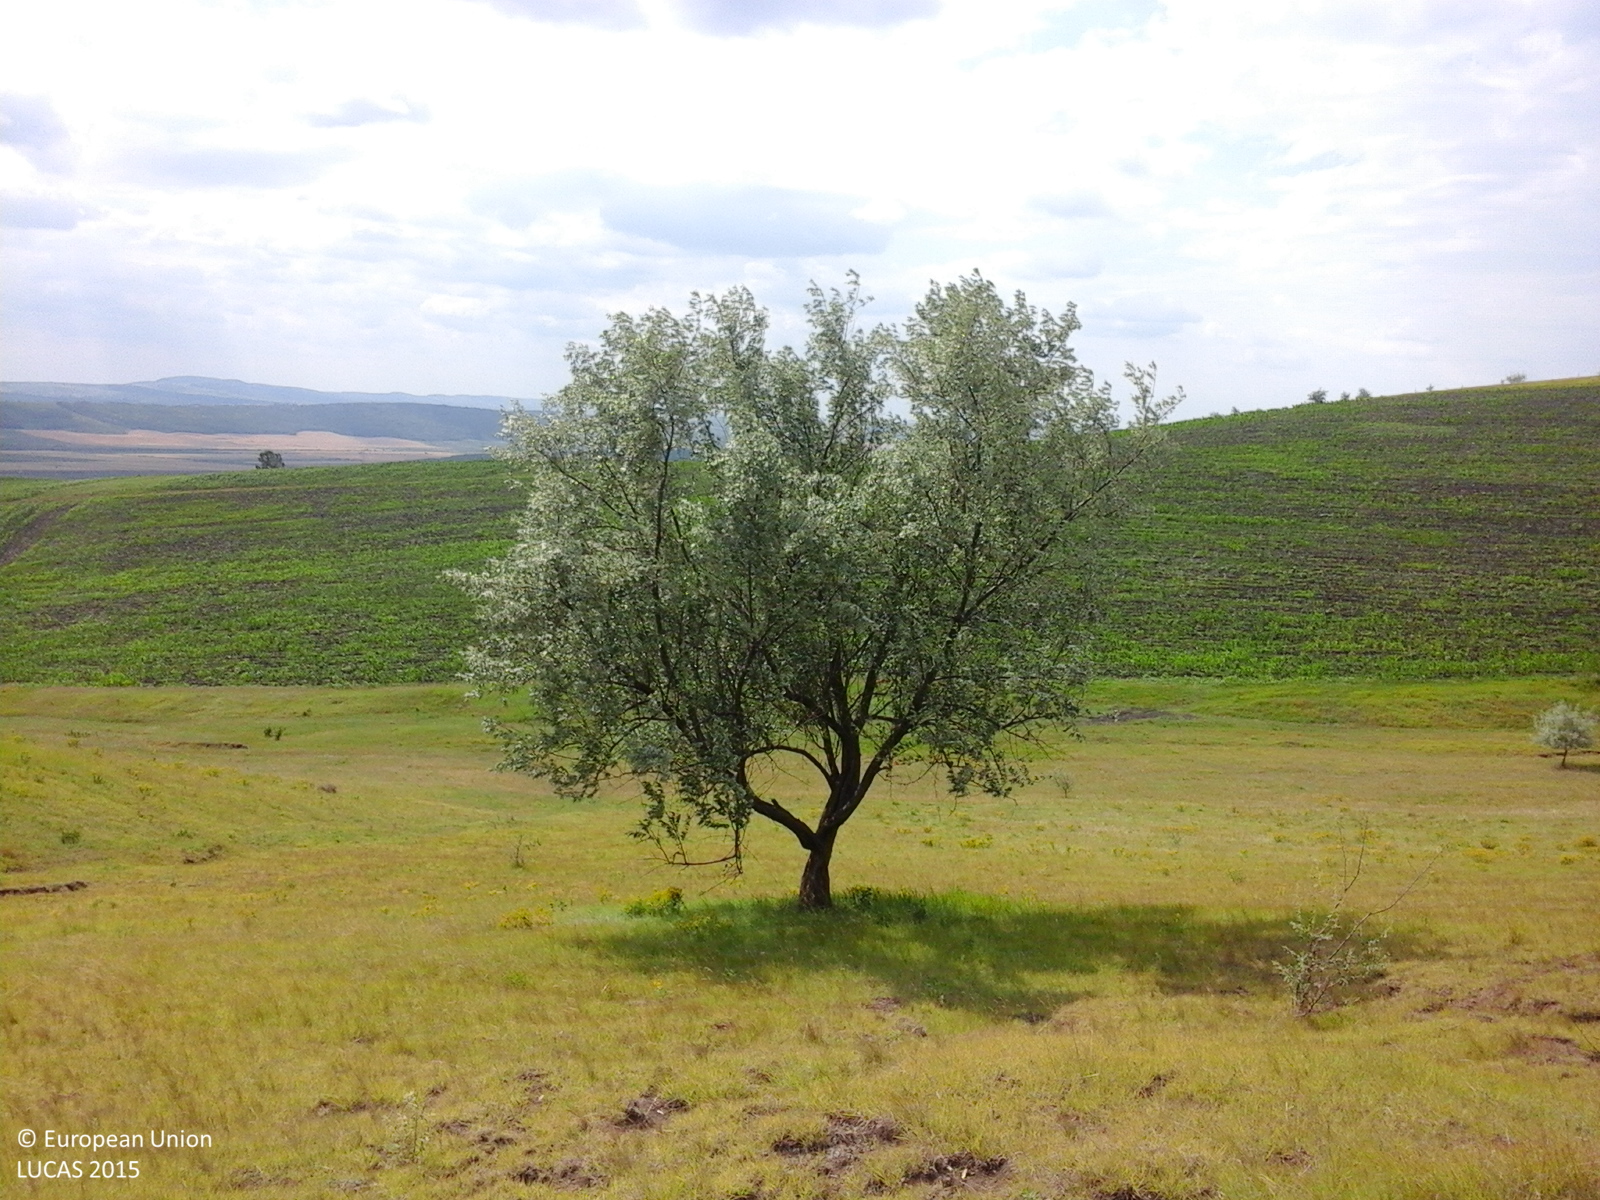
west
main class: Grassland
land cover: Grassland without tree/shrub cover
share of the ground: 50 - 75 %
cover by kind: herbaceous plants 100 %
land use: Agriculture (excluding fallow land and kitchen gardens)
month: June
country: RO
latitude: 46.7048
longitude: 27.6836
